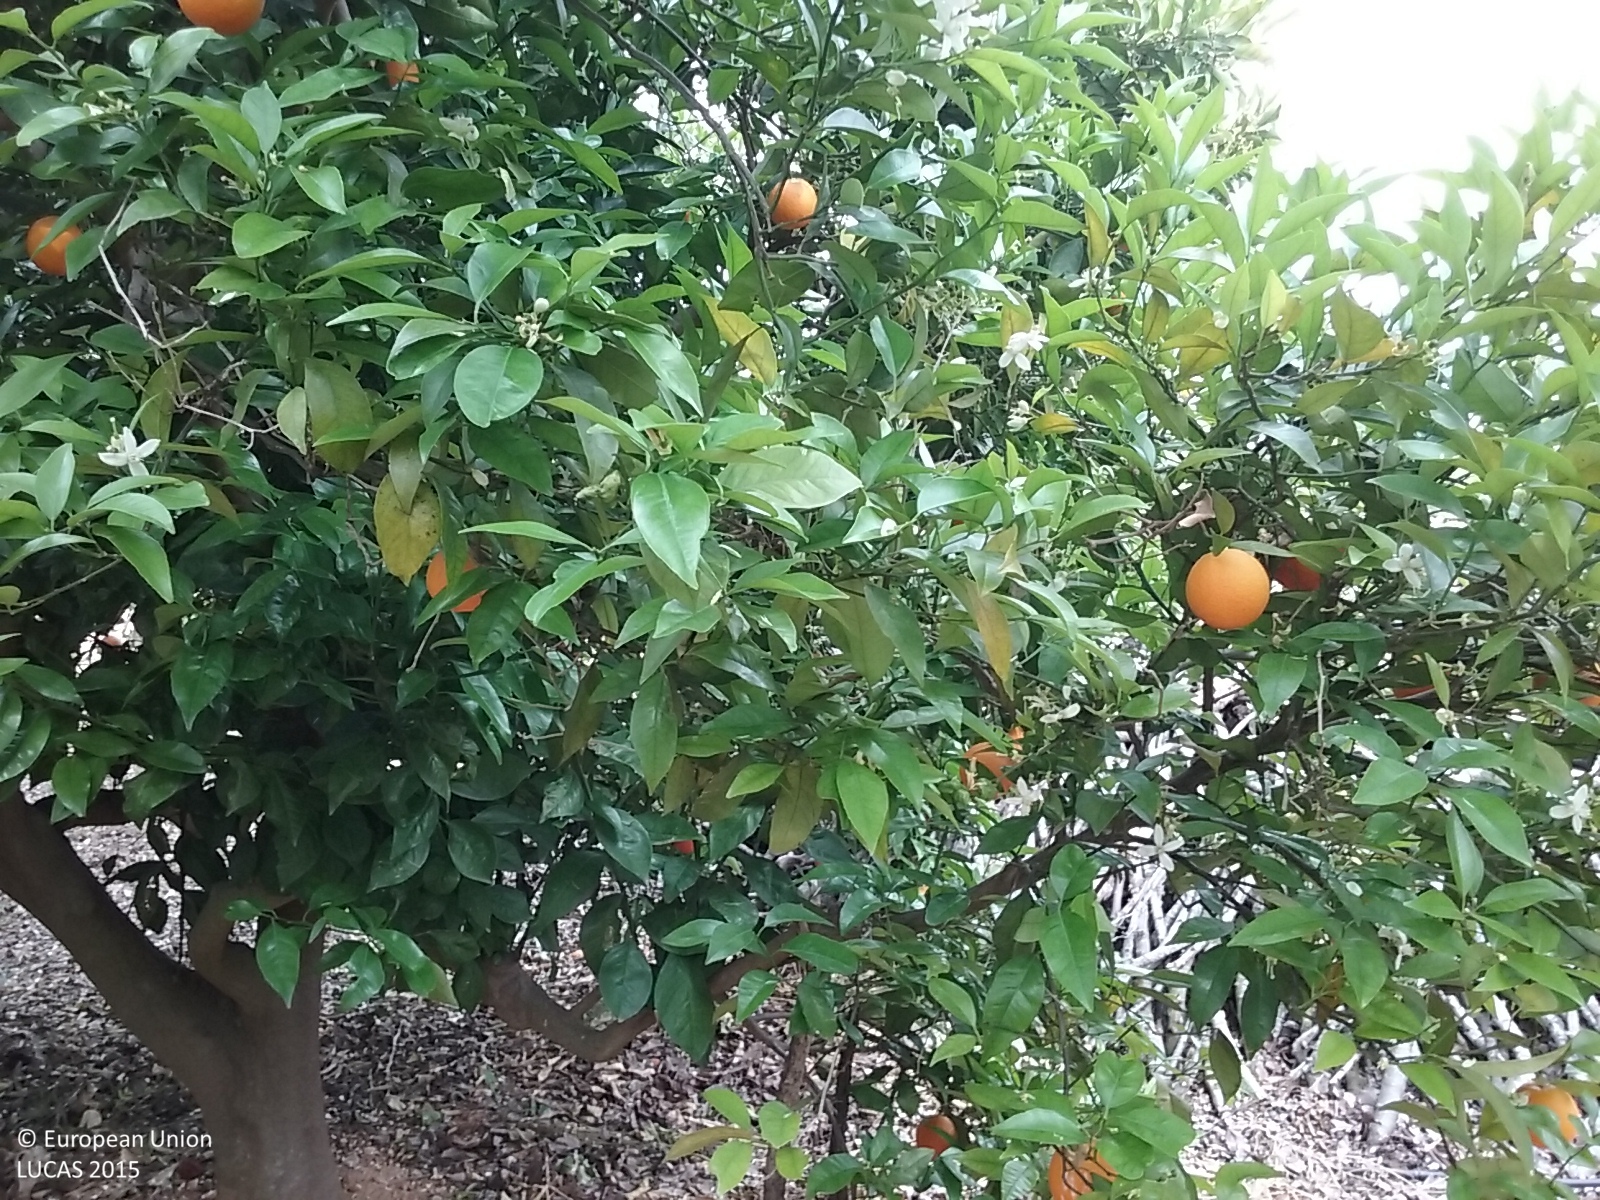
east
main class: Cropland
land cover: Cherry fruit
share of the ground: > 75 %
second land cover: Other bare soil
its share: > 75 %
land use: Agriculture (excluding fallow land and kitchen gardens)
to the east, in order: Cherry fruit; Other bare soil; Oranges; Tracks; Other root crops; Tomatoes; Oranges; Grass margins; Other bare soil; Grass margins; Other bare soil; Dry stone walls; Spontaneously vegetated surfaces; Tracks; Dry stone walls; Shruby margins; Other citrus fruit
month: May
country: ES
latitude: 40.4451
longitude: 0.3402
